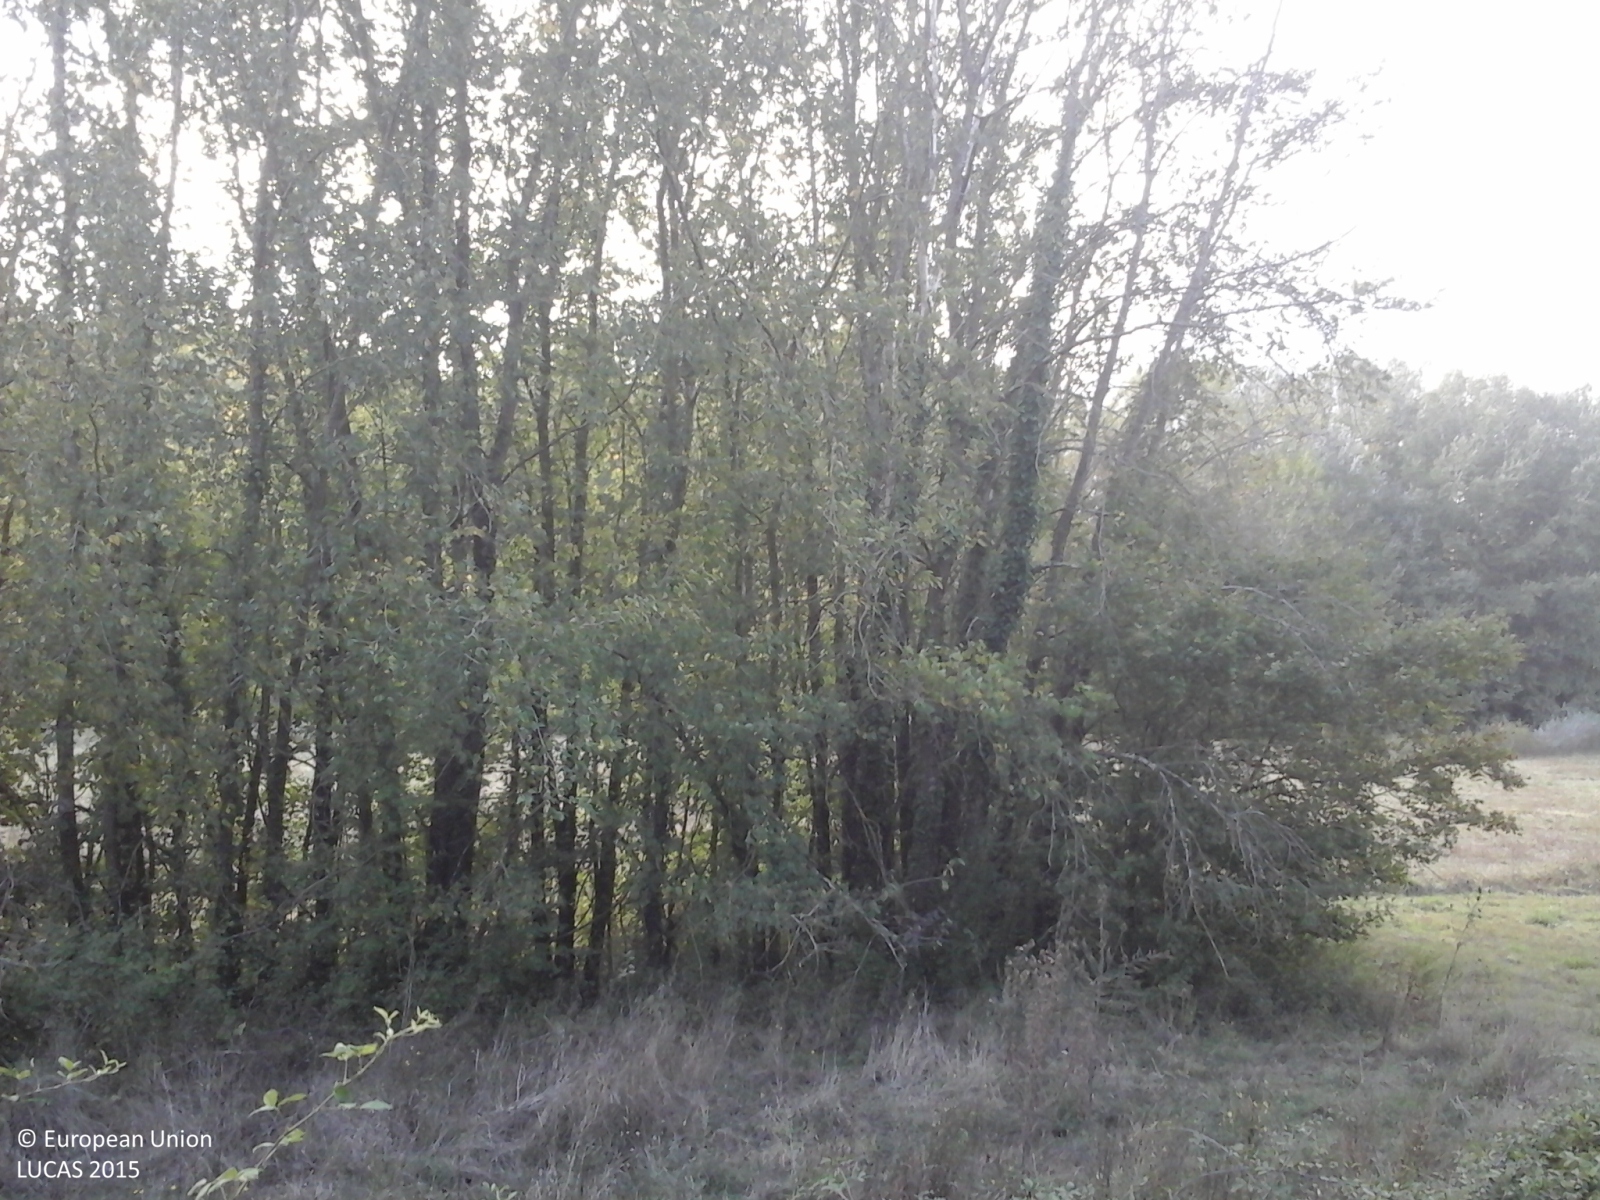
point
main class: Woodland
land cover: Broadleaved woodland
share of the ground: > 75 %
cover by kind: broadleaved forest trees 95 %, herbaceous plants 5 %
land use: Semi-natural and natural areas not in use
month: October
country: IT
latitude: 43.2623
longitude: 12.1989
